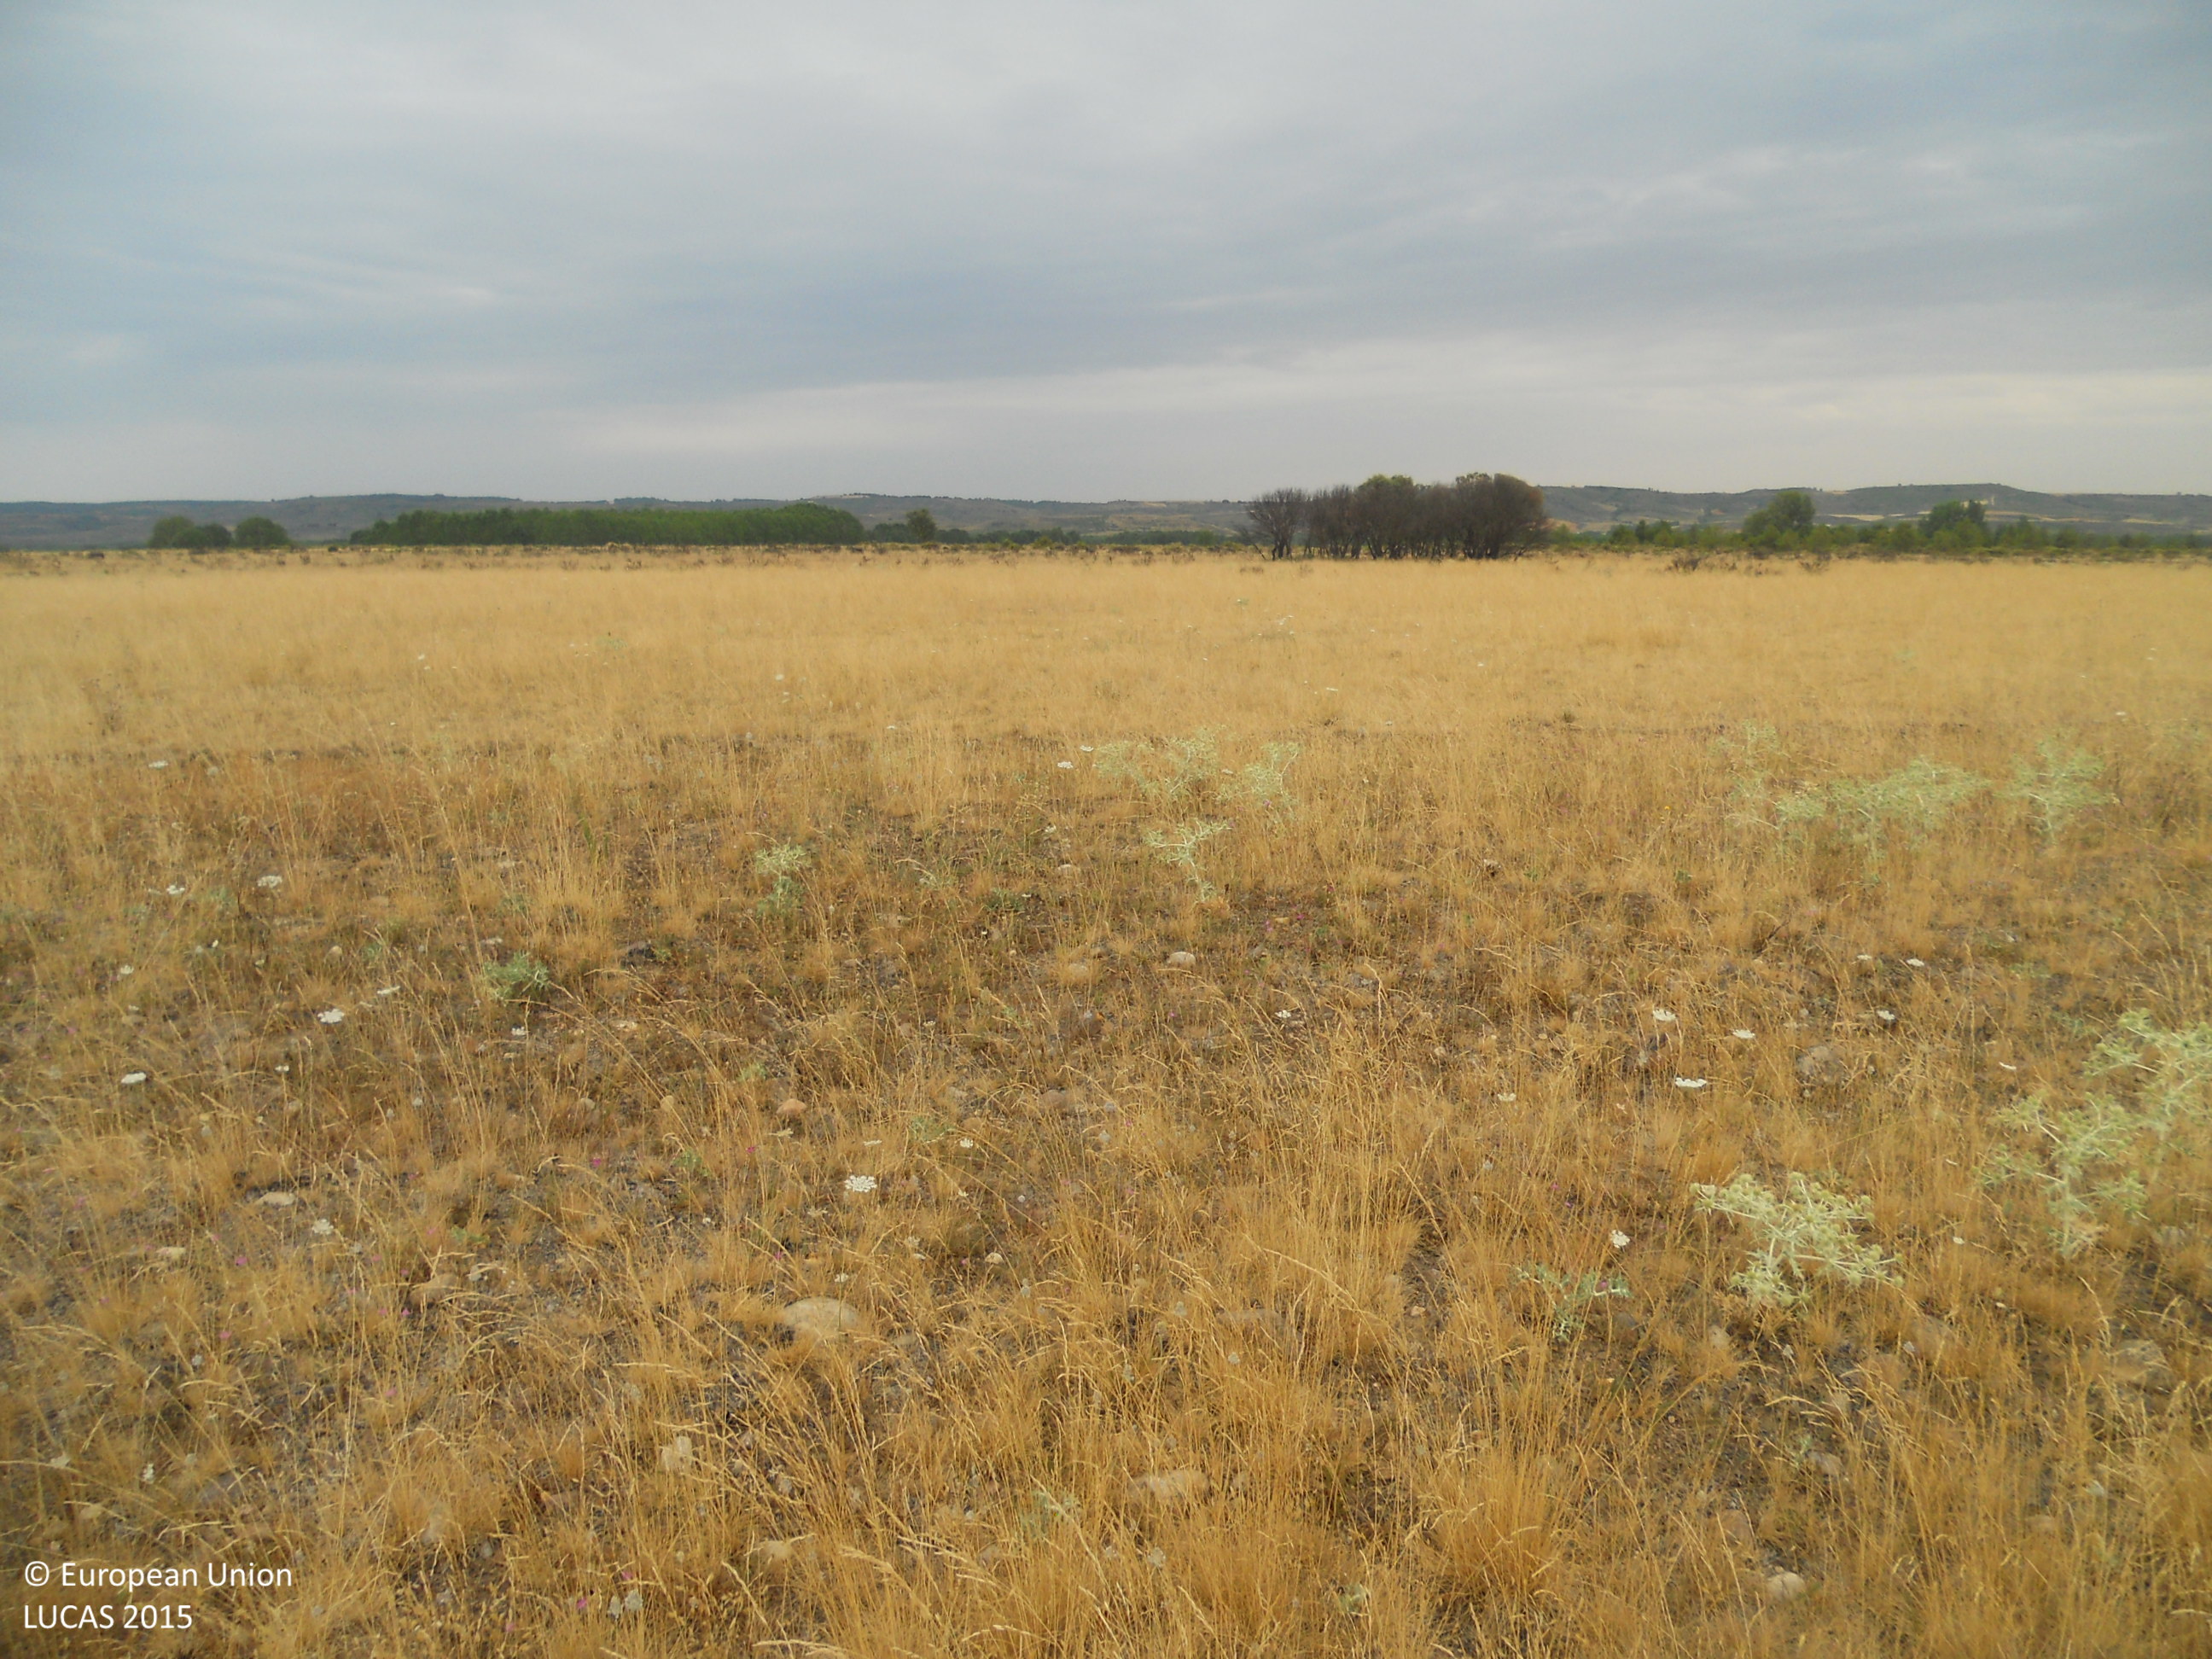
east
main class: Grassland
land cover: Spontaneously vegetated surfaces
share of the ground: > 75 %
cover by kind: herbaceous plants 100 %
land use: Fallow land
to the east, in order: Spontaneously vegetated surfaces; Ditches and canals; Grassland without tree/shrub cover; Tracks; Grass margins; Oats; Spontaneously vegetated surfaces
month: July
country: ES
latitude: 42.6211
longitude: -5.4197
